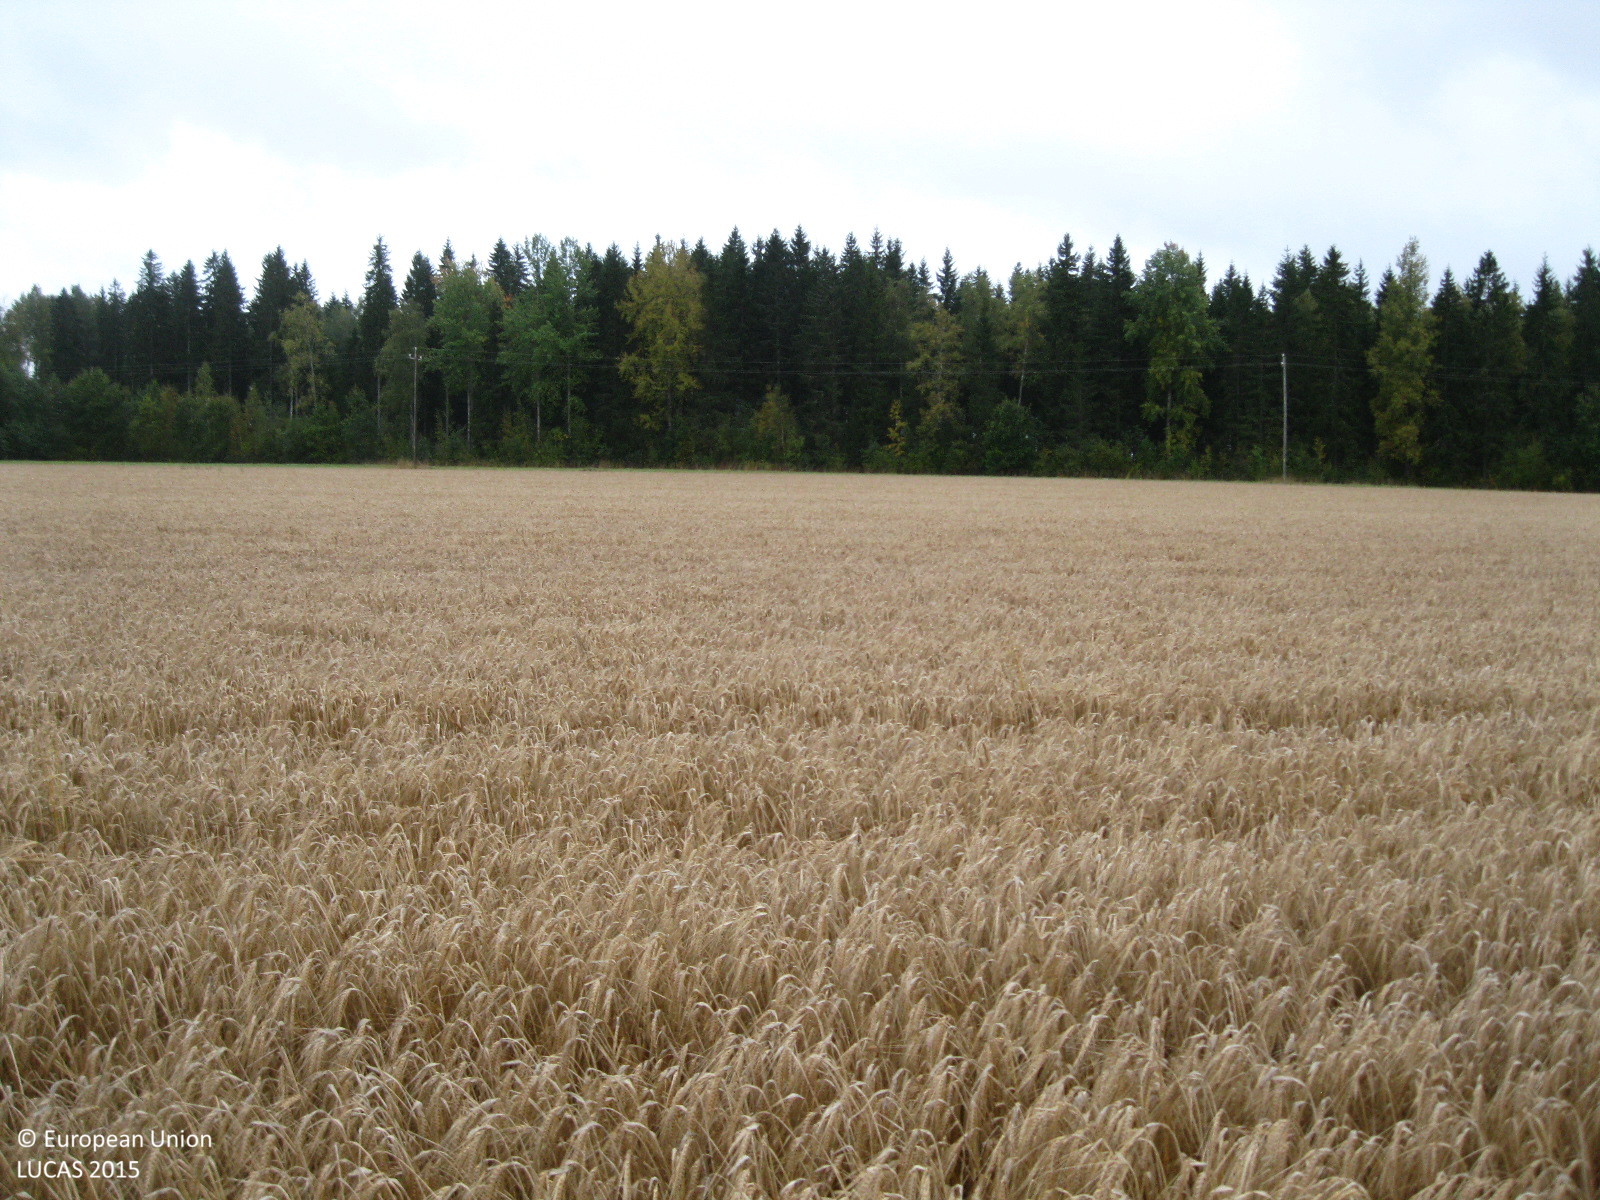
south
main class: Cropland
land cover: Barley
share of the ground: > 75 %
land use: Agriculture (excluding fallow land and kitchen gardens)
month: September
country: FI
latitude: 60.8299
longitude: 24.7686
